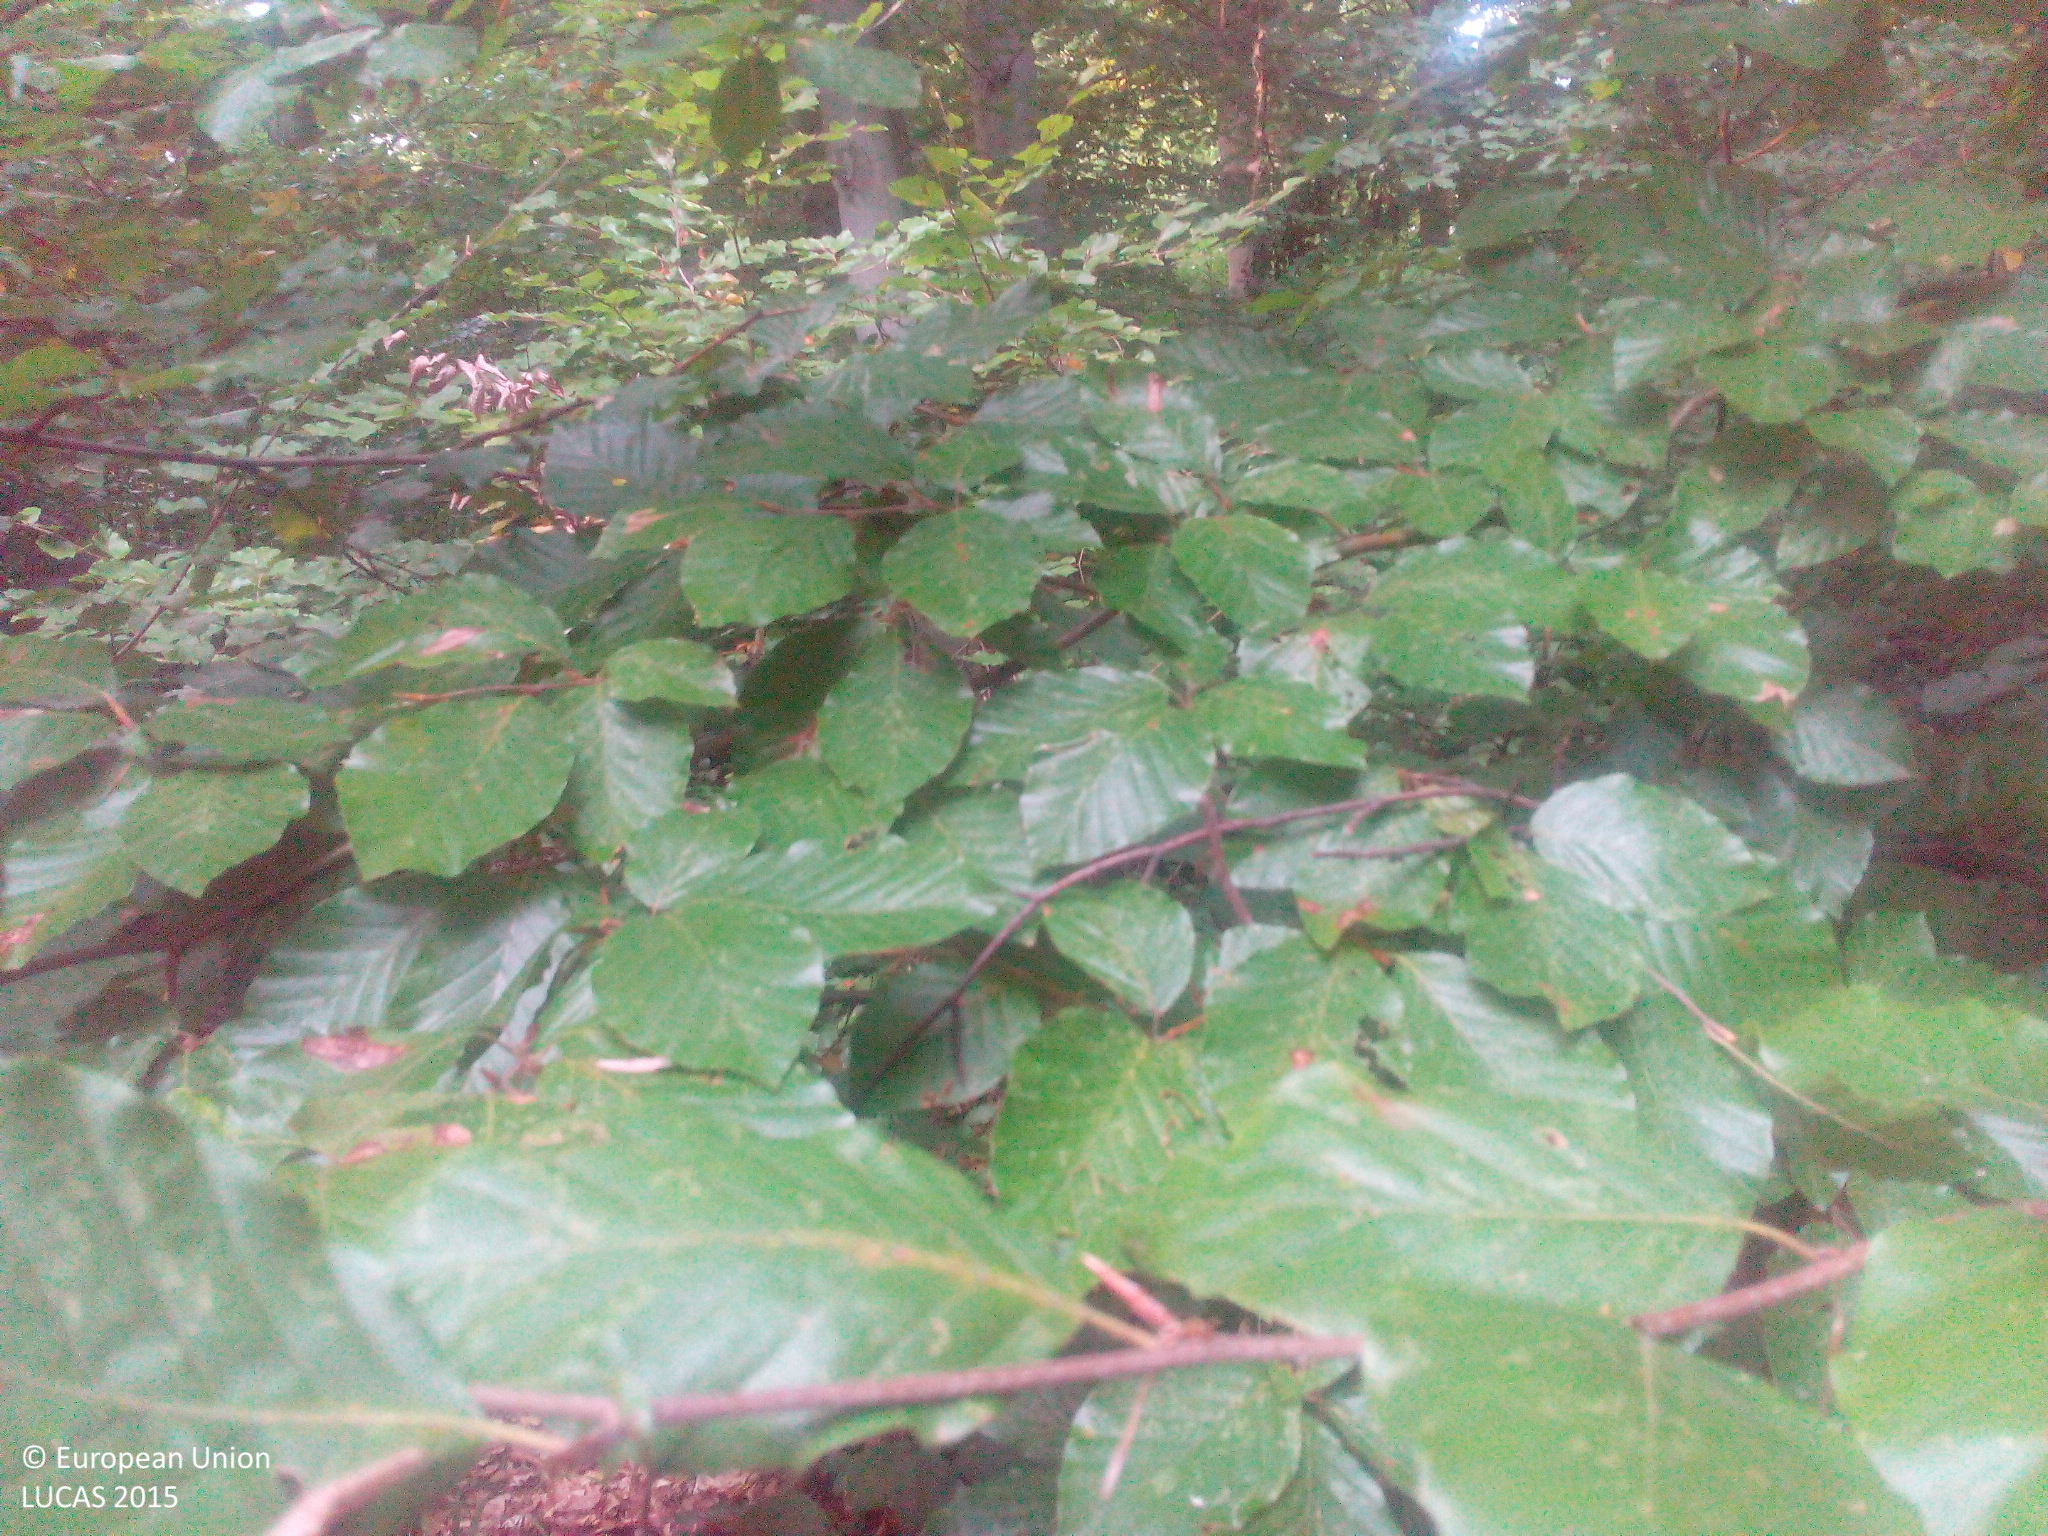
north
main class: Woodland
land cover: Broadleaved woodland
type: beech forest
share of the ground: > 75 %
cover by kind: broadleaved forest trees 100 %
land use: Forestry
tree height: > 5 m
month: September
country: DE
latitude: 51.3839
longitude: 11.0774
